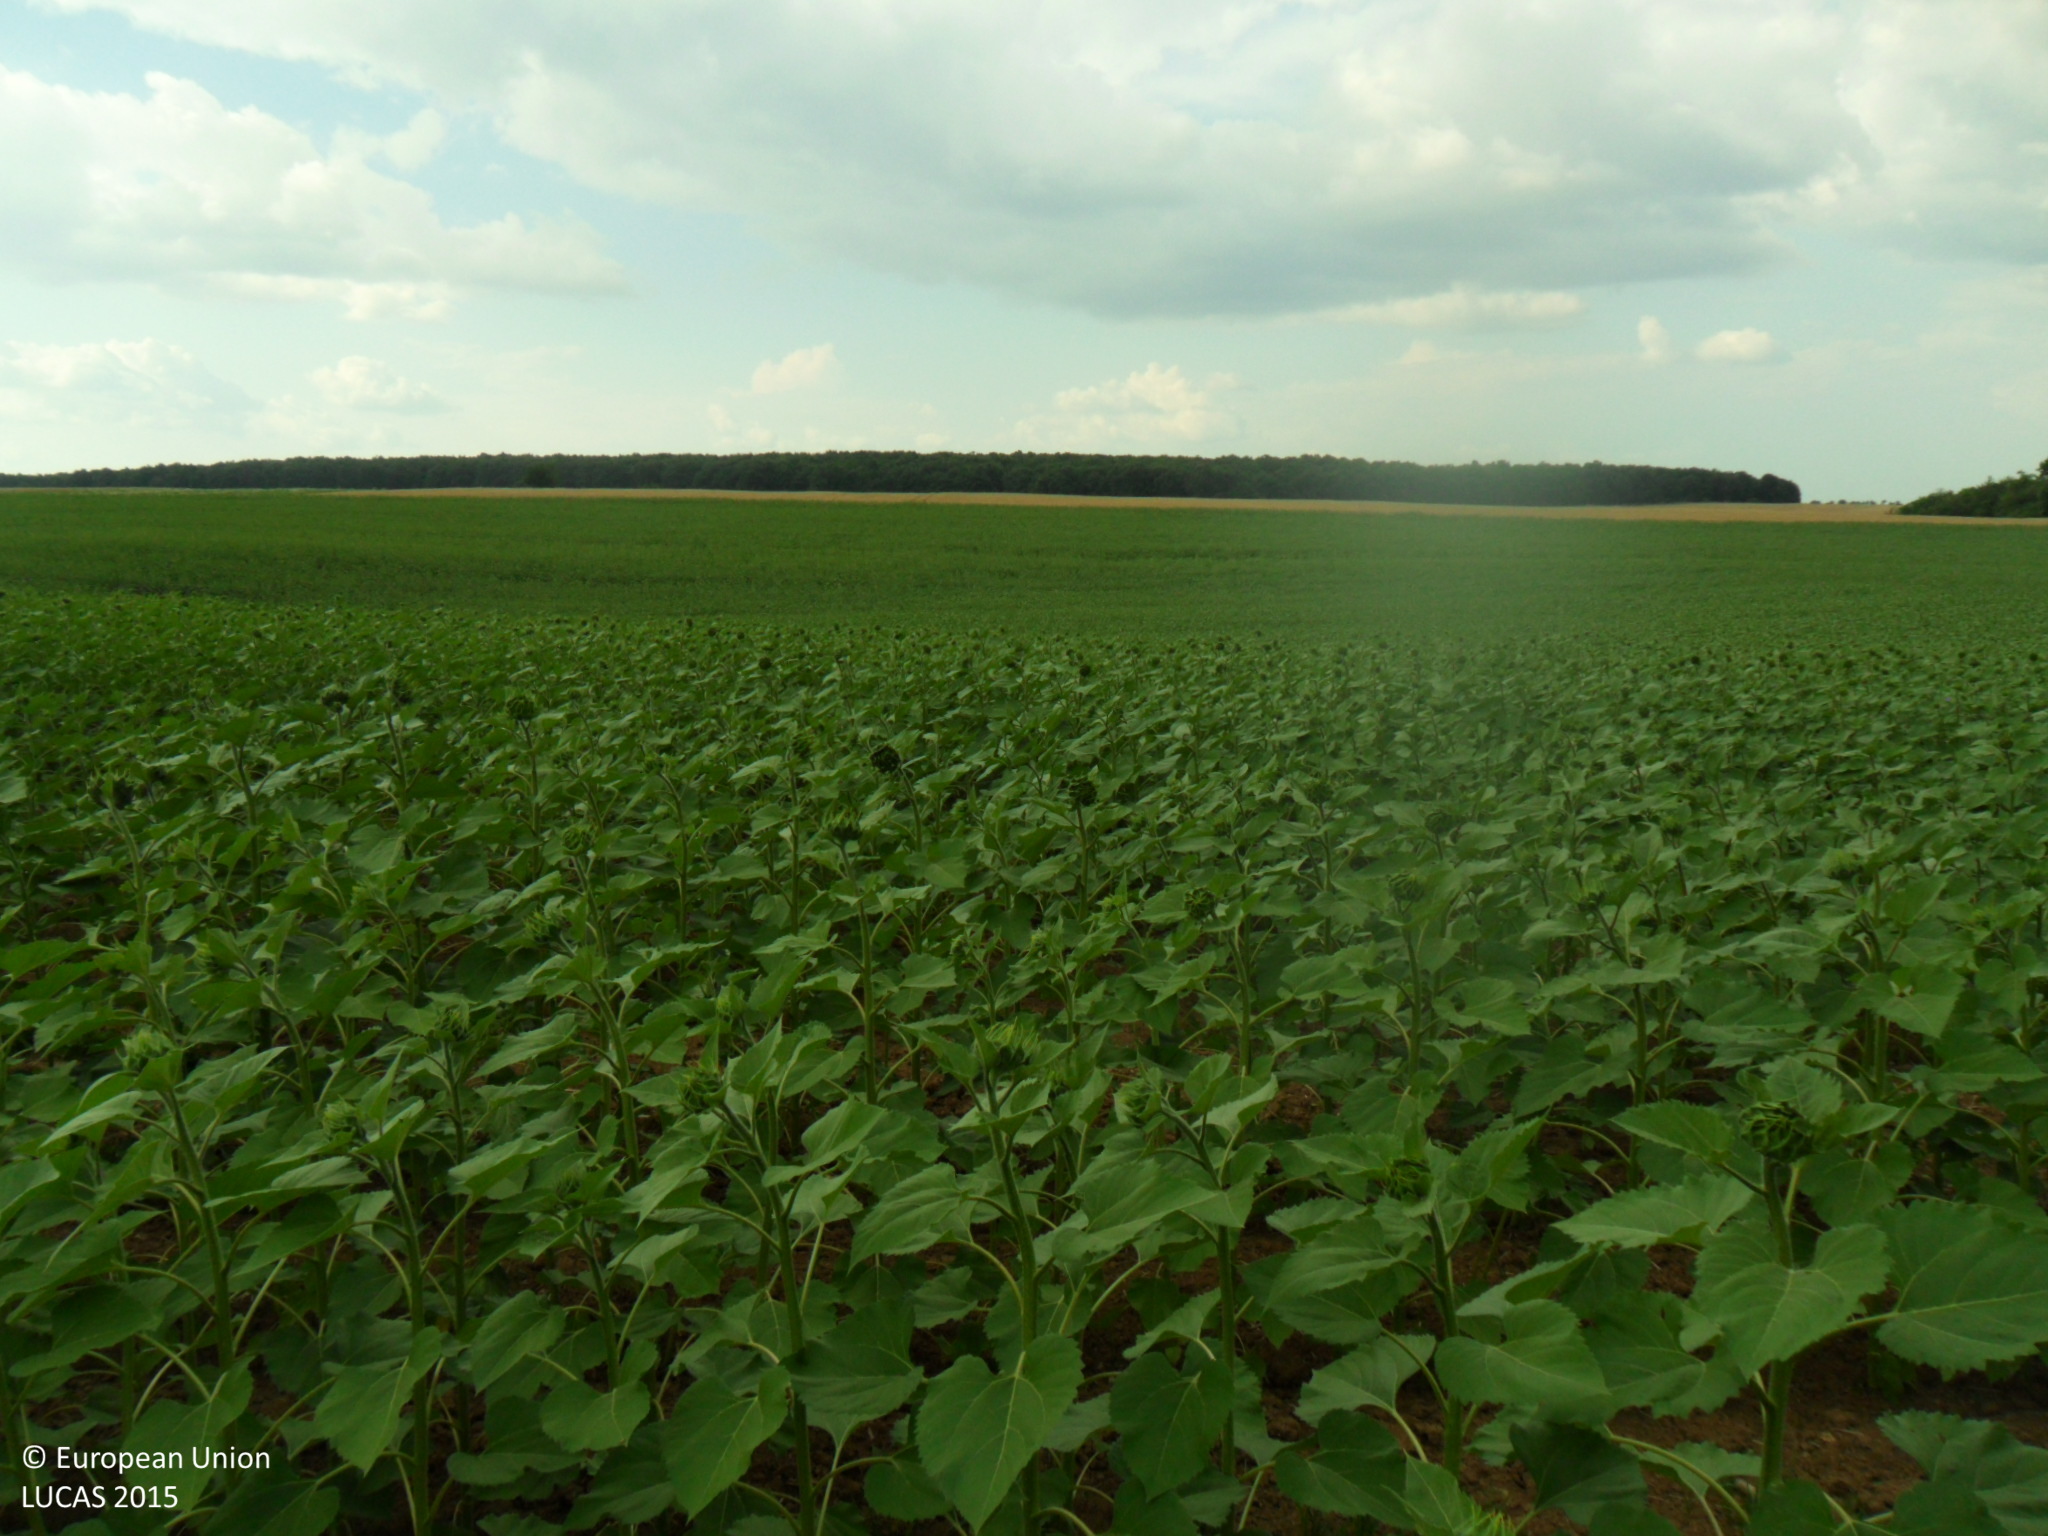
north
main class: Cropland
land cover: Sunflower
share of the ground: > 75 %
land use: Agriculture (excluding fallow land and kitchen gardens)
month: July
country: BG
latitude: 43.6040
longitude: 26.8520
